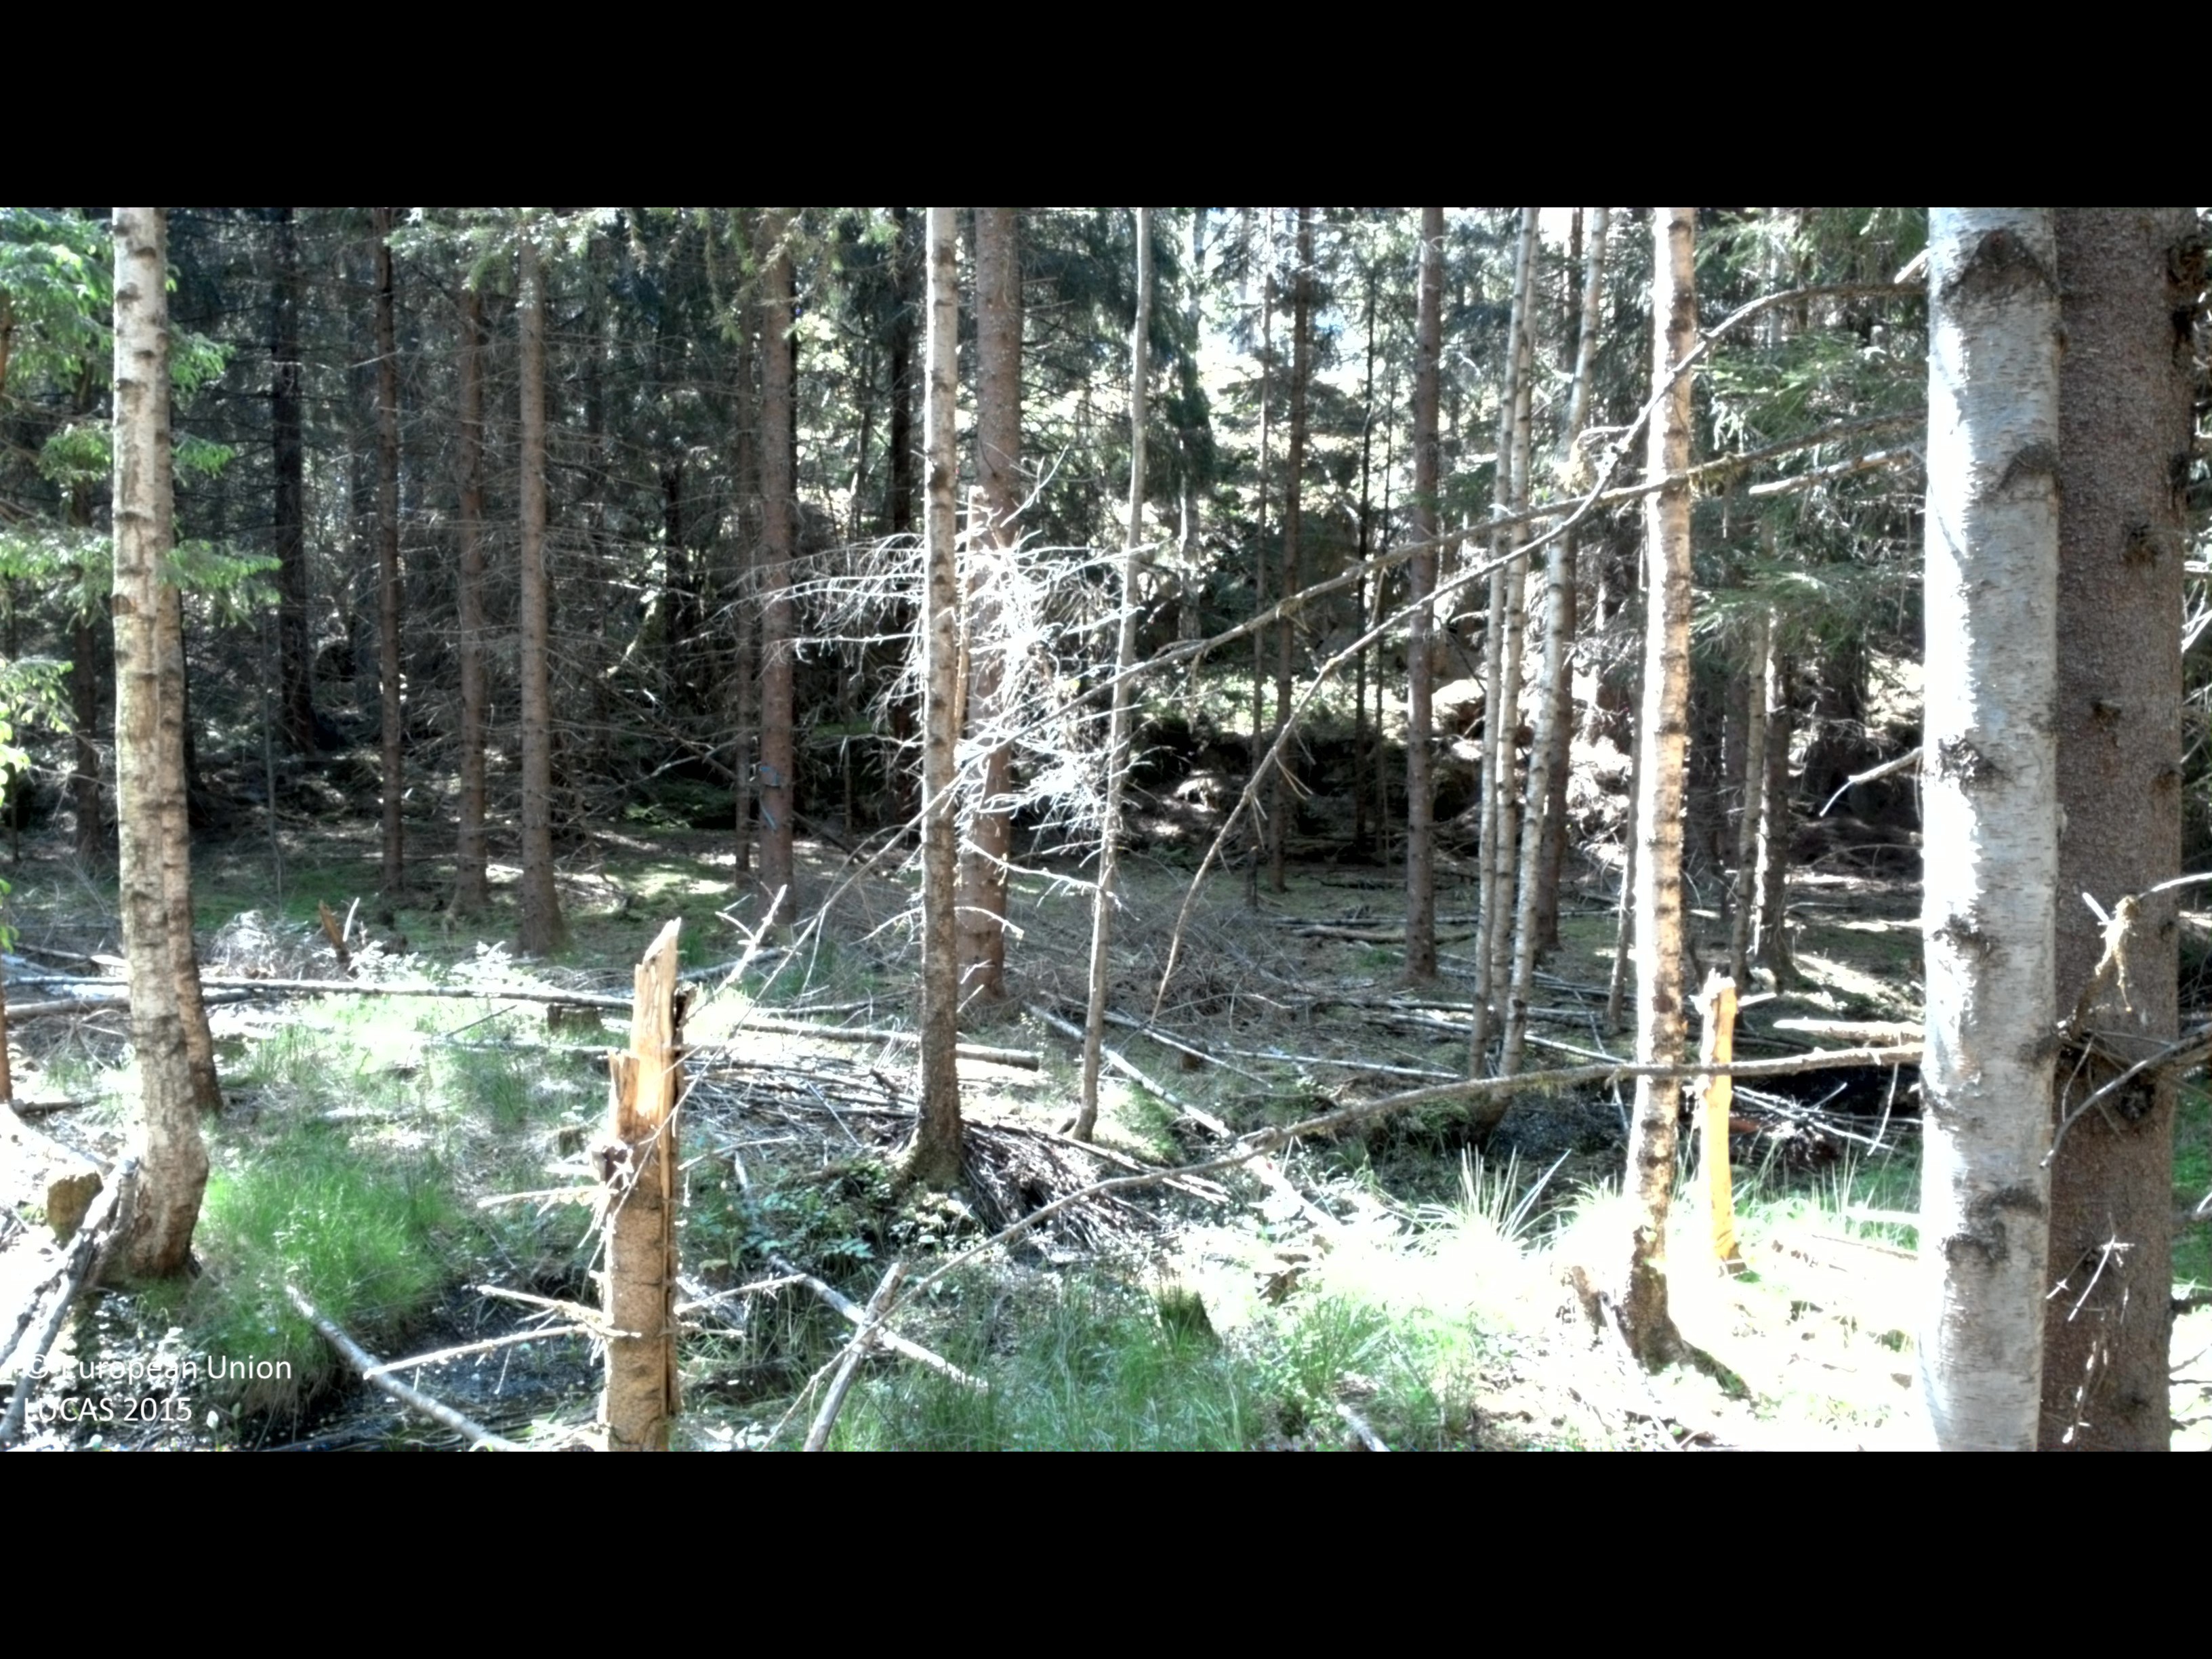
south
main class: Woodland
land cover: Spruce dominated coniferous woodland
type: boreal forest
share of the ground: 50 - 75 %
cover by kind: coniferous forest trees 55 %, herbaceous plants 25 %, broadleaved forest trees 10 %, unconsolidated bare surface 5 %
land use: Forestry
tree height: > 5 m
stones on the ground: < 10 %
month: June
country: SE
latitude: 57.7518
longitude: 16.1980
